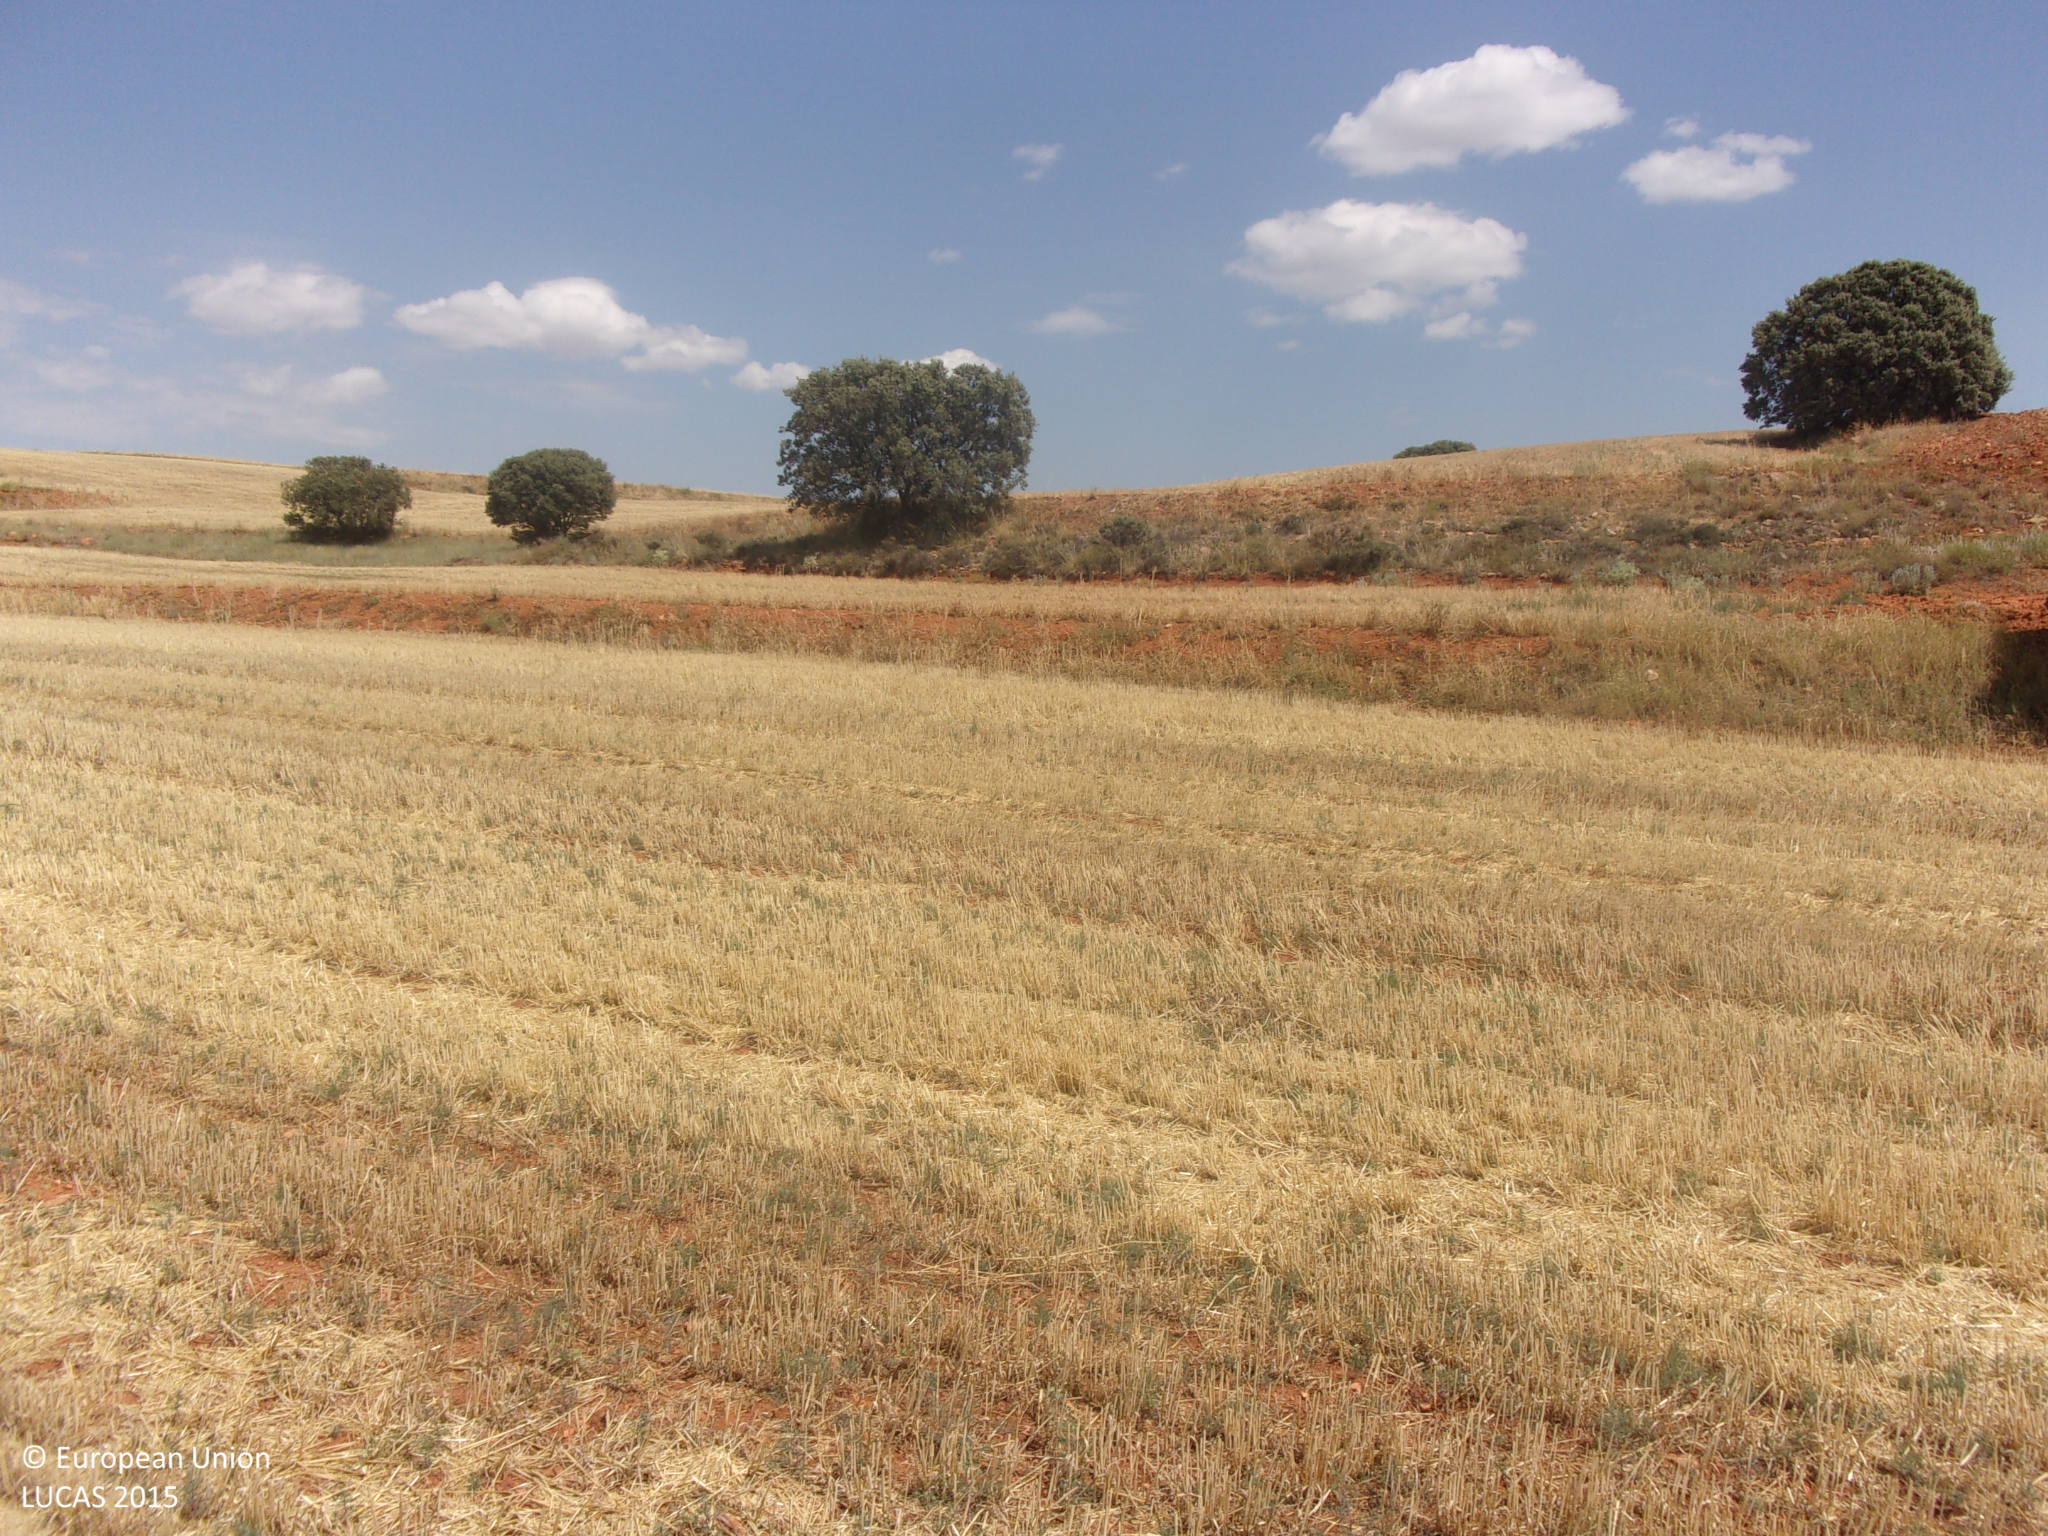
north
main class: Cropland
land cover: Barley
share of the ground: < 10 %
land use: Agriculture (excluding fallow land and kitchen gardens)
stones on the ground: < 10 %
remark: Harvested field
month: July
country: ES
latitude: 41.1016
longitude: -1.8240
